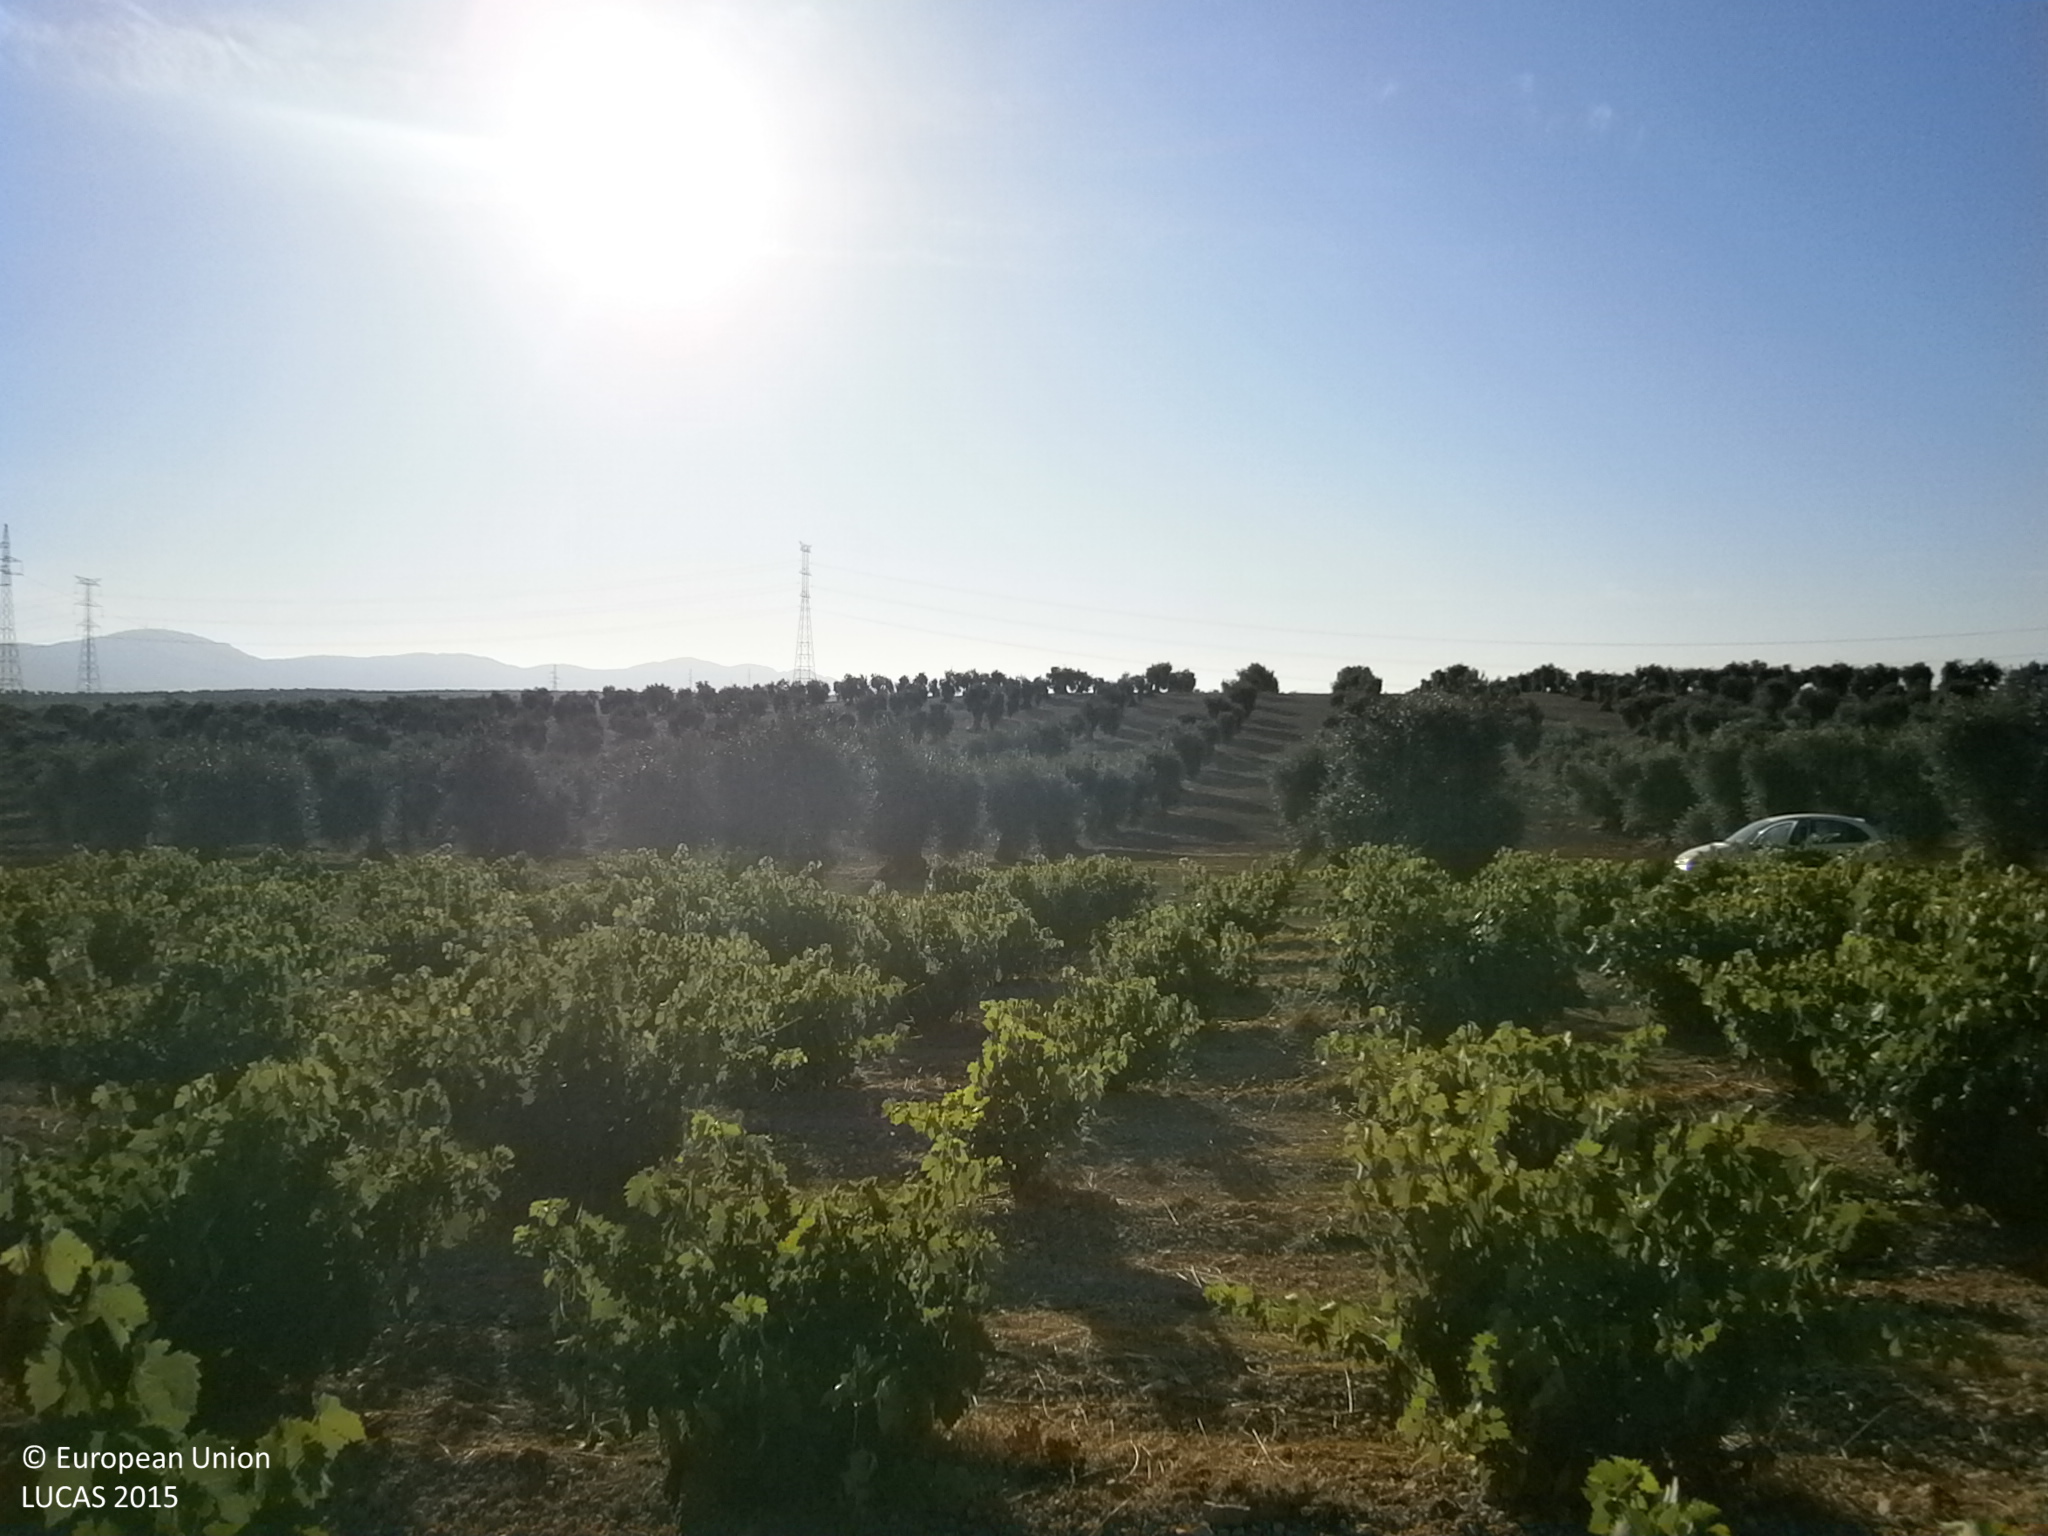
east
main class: Cropland
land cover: Vineyards
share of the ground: 25 - 50 %
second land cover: Other bare soil
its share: > 75 %
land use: Agriculture (excluding fallow land and kitchen gardens)
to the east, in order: Vineyards; Other bare soil; Olive groves; Tracks; Olive groves
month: June
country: ES
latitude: 38.8194
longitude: -6.5179
